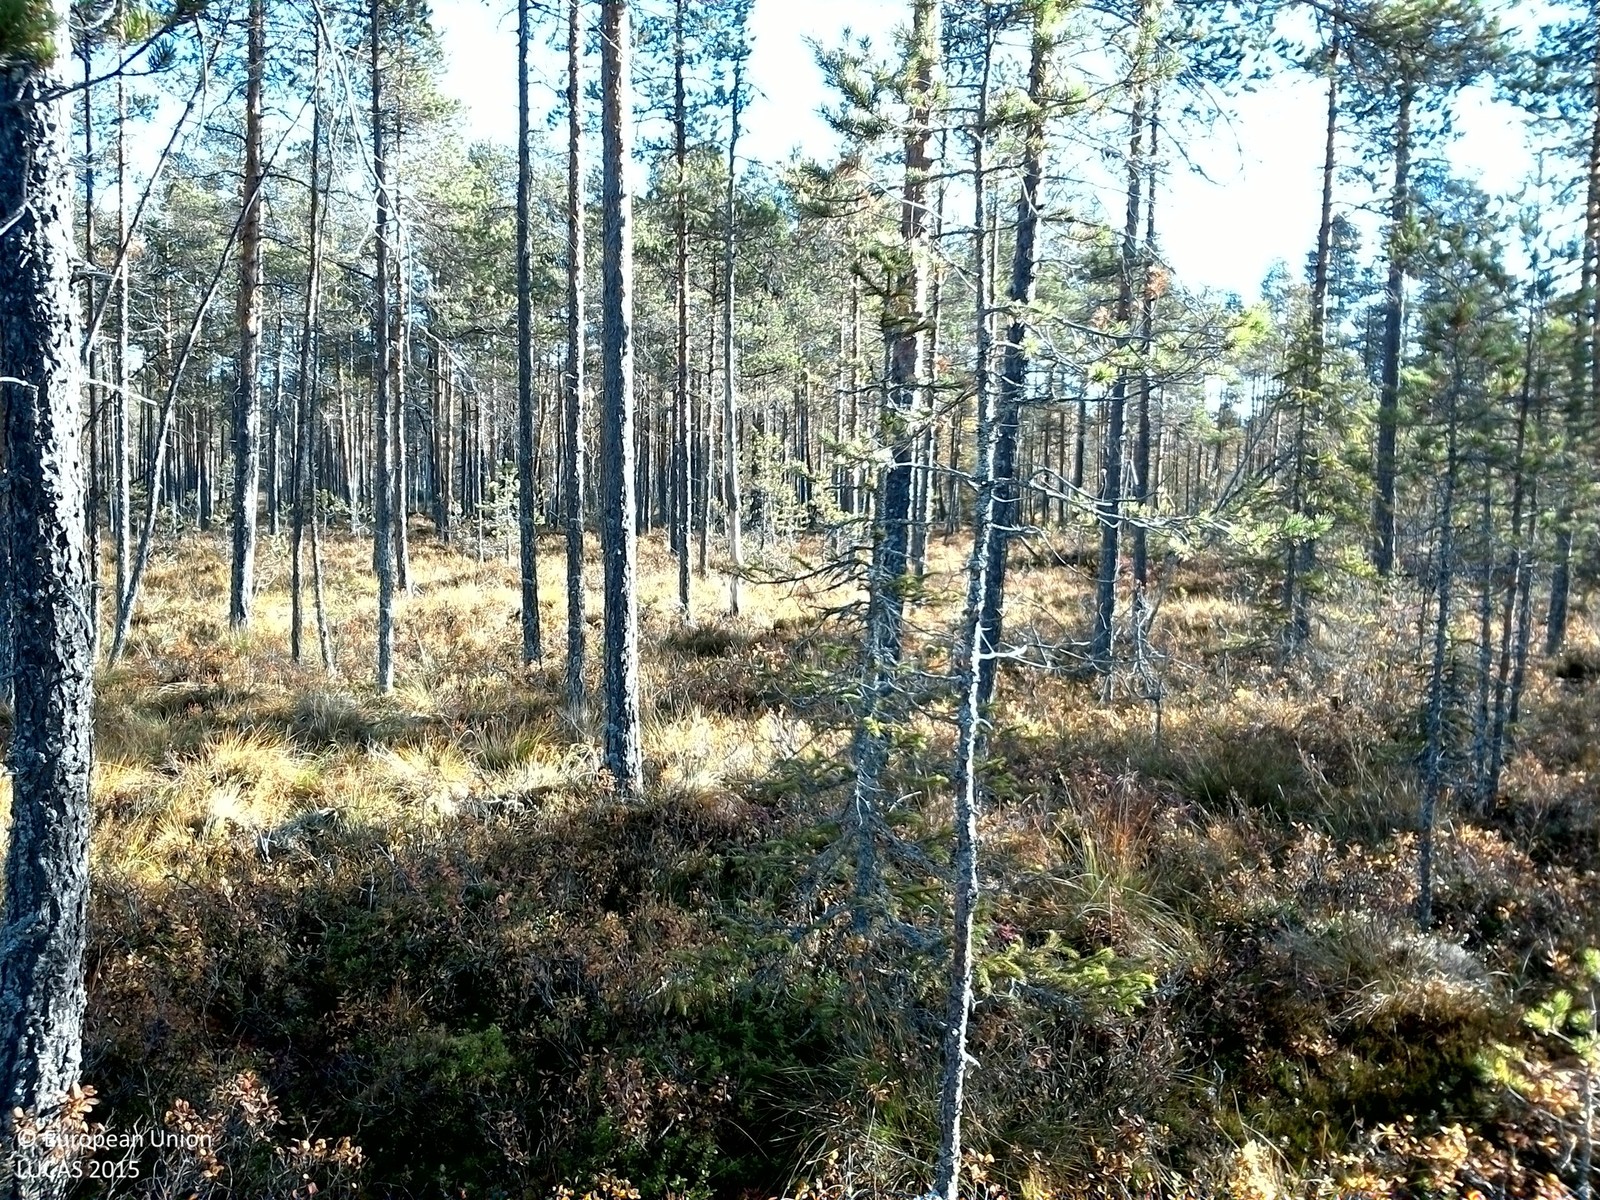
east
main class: Woodland
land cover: Pine dominated coniferous woodland
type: boreal forest
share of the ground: 50 - 75 %
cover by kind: coniferous forest trees 50 %, shrubs 30 %, lichens and mosses 15 %, herbaceous plants 5 %
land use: Forestry
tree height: > 5 m
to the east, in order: Pine dominated coniferous woodland; Pine dominated mixed woodland; Inland marshes; Rivers and streams; Pine dominated mixed woodland; Peatbogs; Pine dominated mixed woodland; Peatbogs; Pine dominated mixed woodland; Shrubland with sparse tree cover; Pine dominated mixed woodland
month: October
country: SE
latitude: 61.1828
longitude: 15.2856
